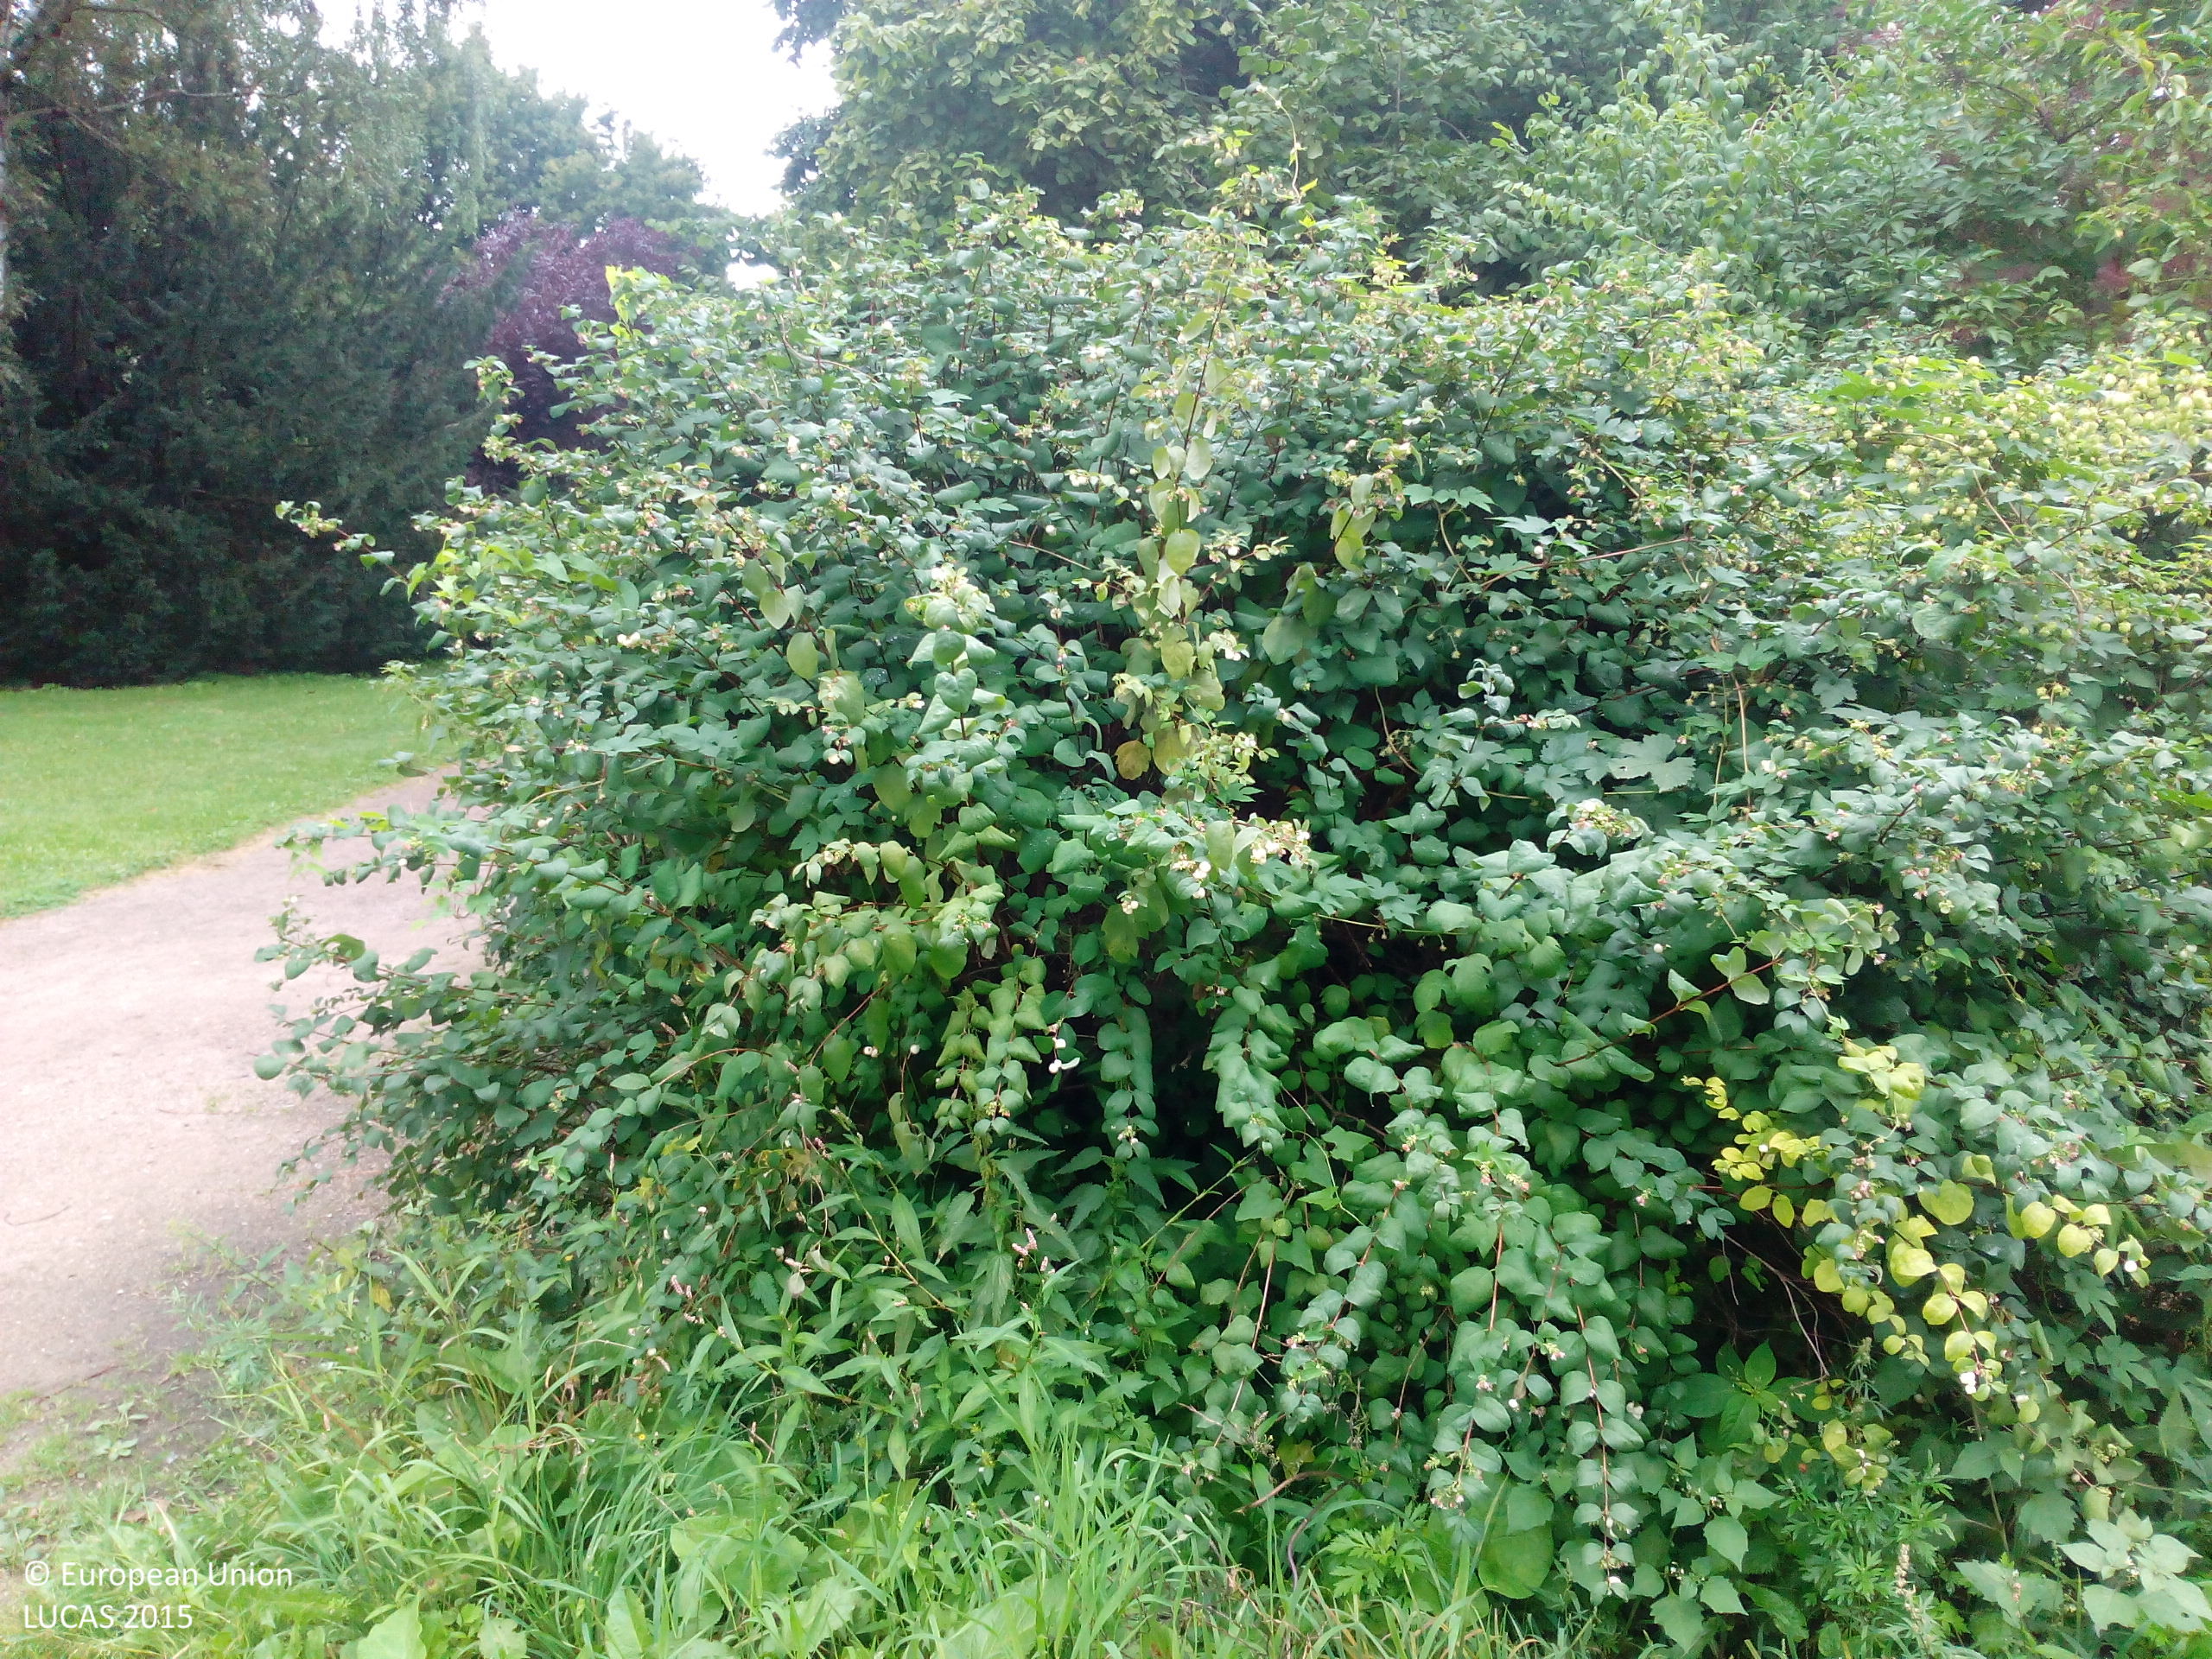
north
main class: Grassland
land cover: Spontaneously vegetated surfaces
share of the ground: > 75 %
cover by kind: herbaceous plants 95 %, shrubs 5 %
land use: Amenities, museums, leisure
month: August
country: DE
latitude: 53.5457
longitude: 9.9246
